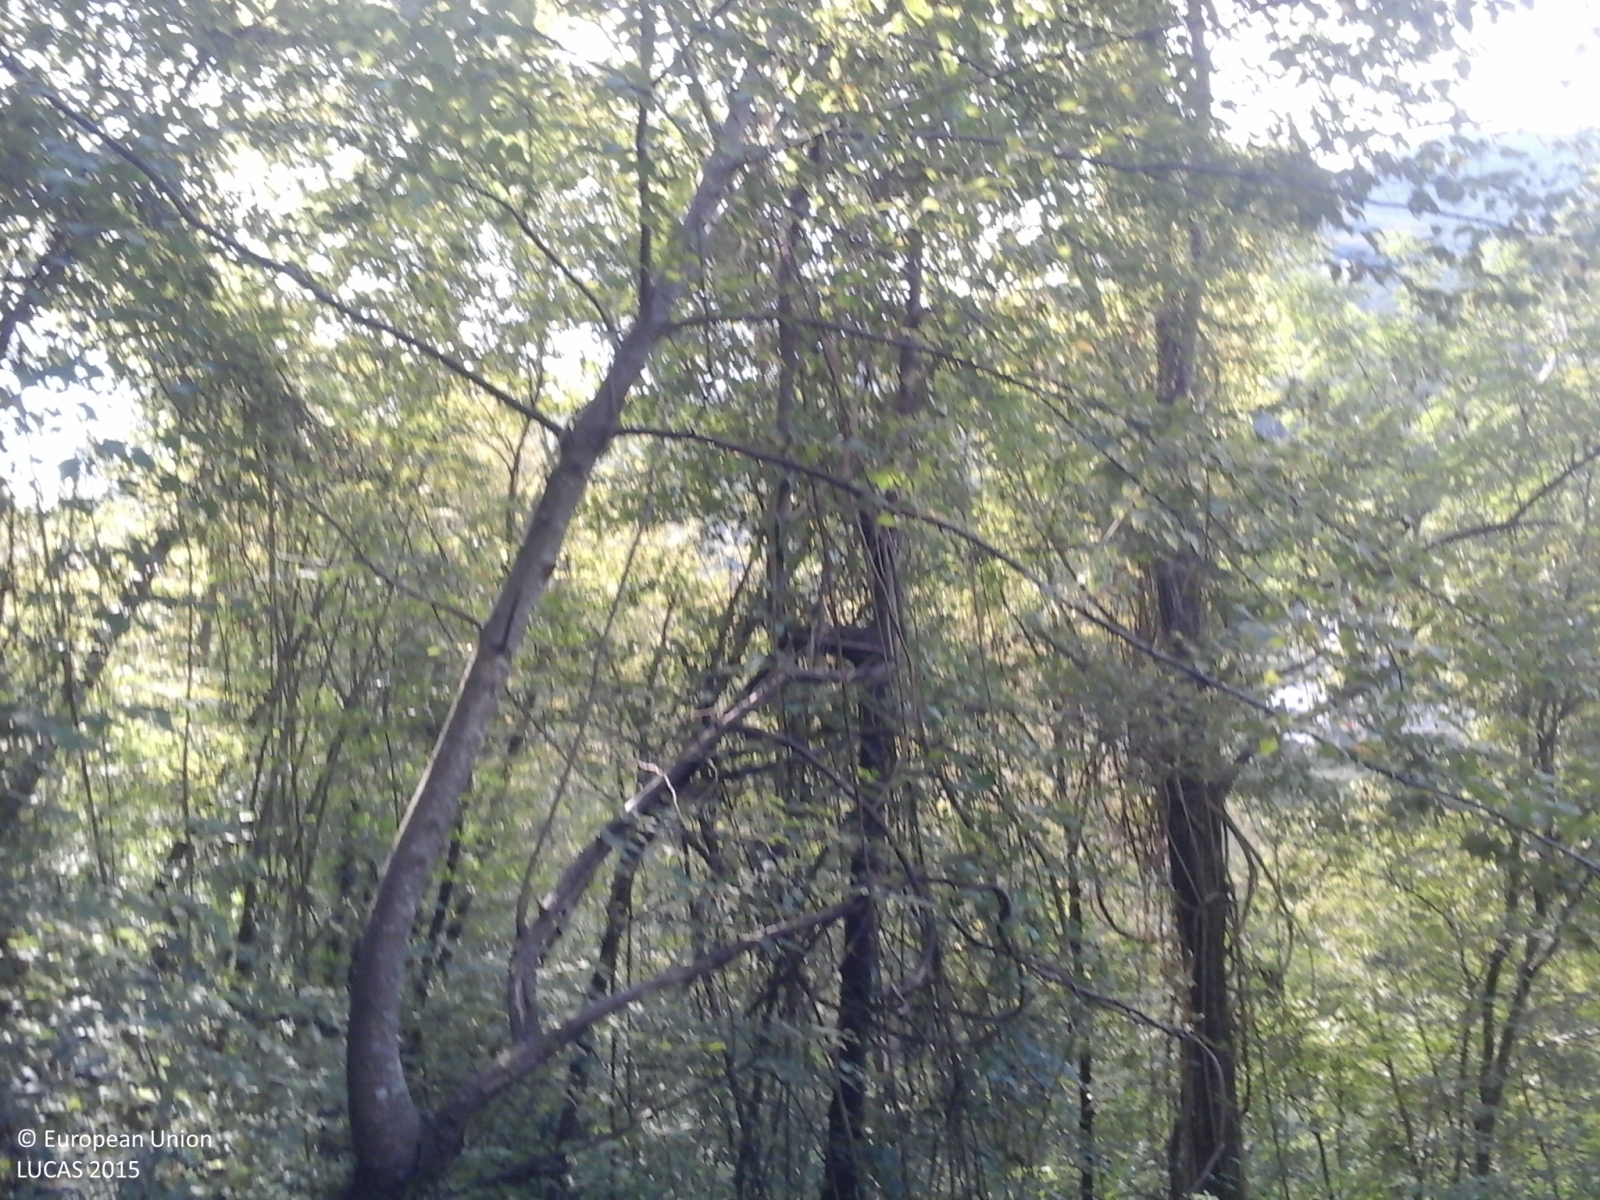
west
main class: Woodland
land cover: Broadleaved woodland
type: thermophilous deciduous forest
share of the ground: > 75 %
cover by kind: broadleaved forest trees 90 %, herbaceous plants 10 %
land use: Semi-natural and natural areas not in use
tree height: > 5 m
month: September
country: IT
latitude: 44.4201
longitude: 9.2606
